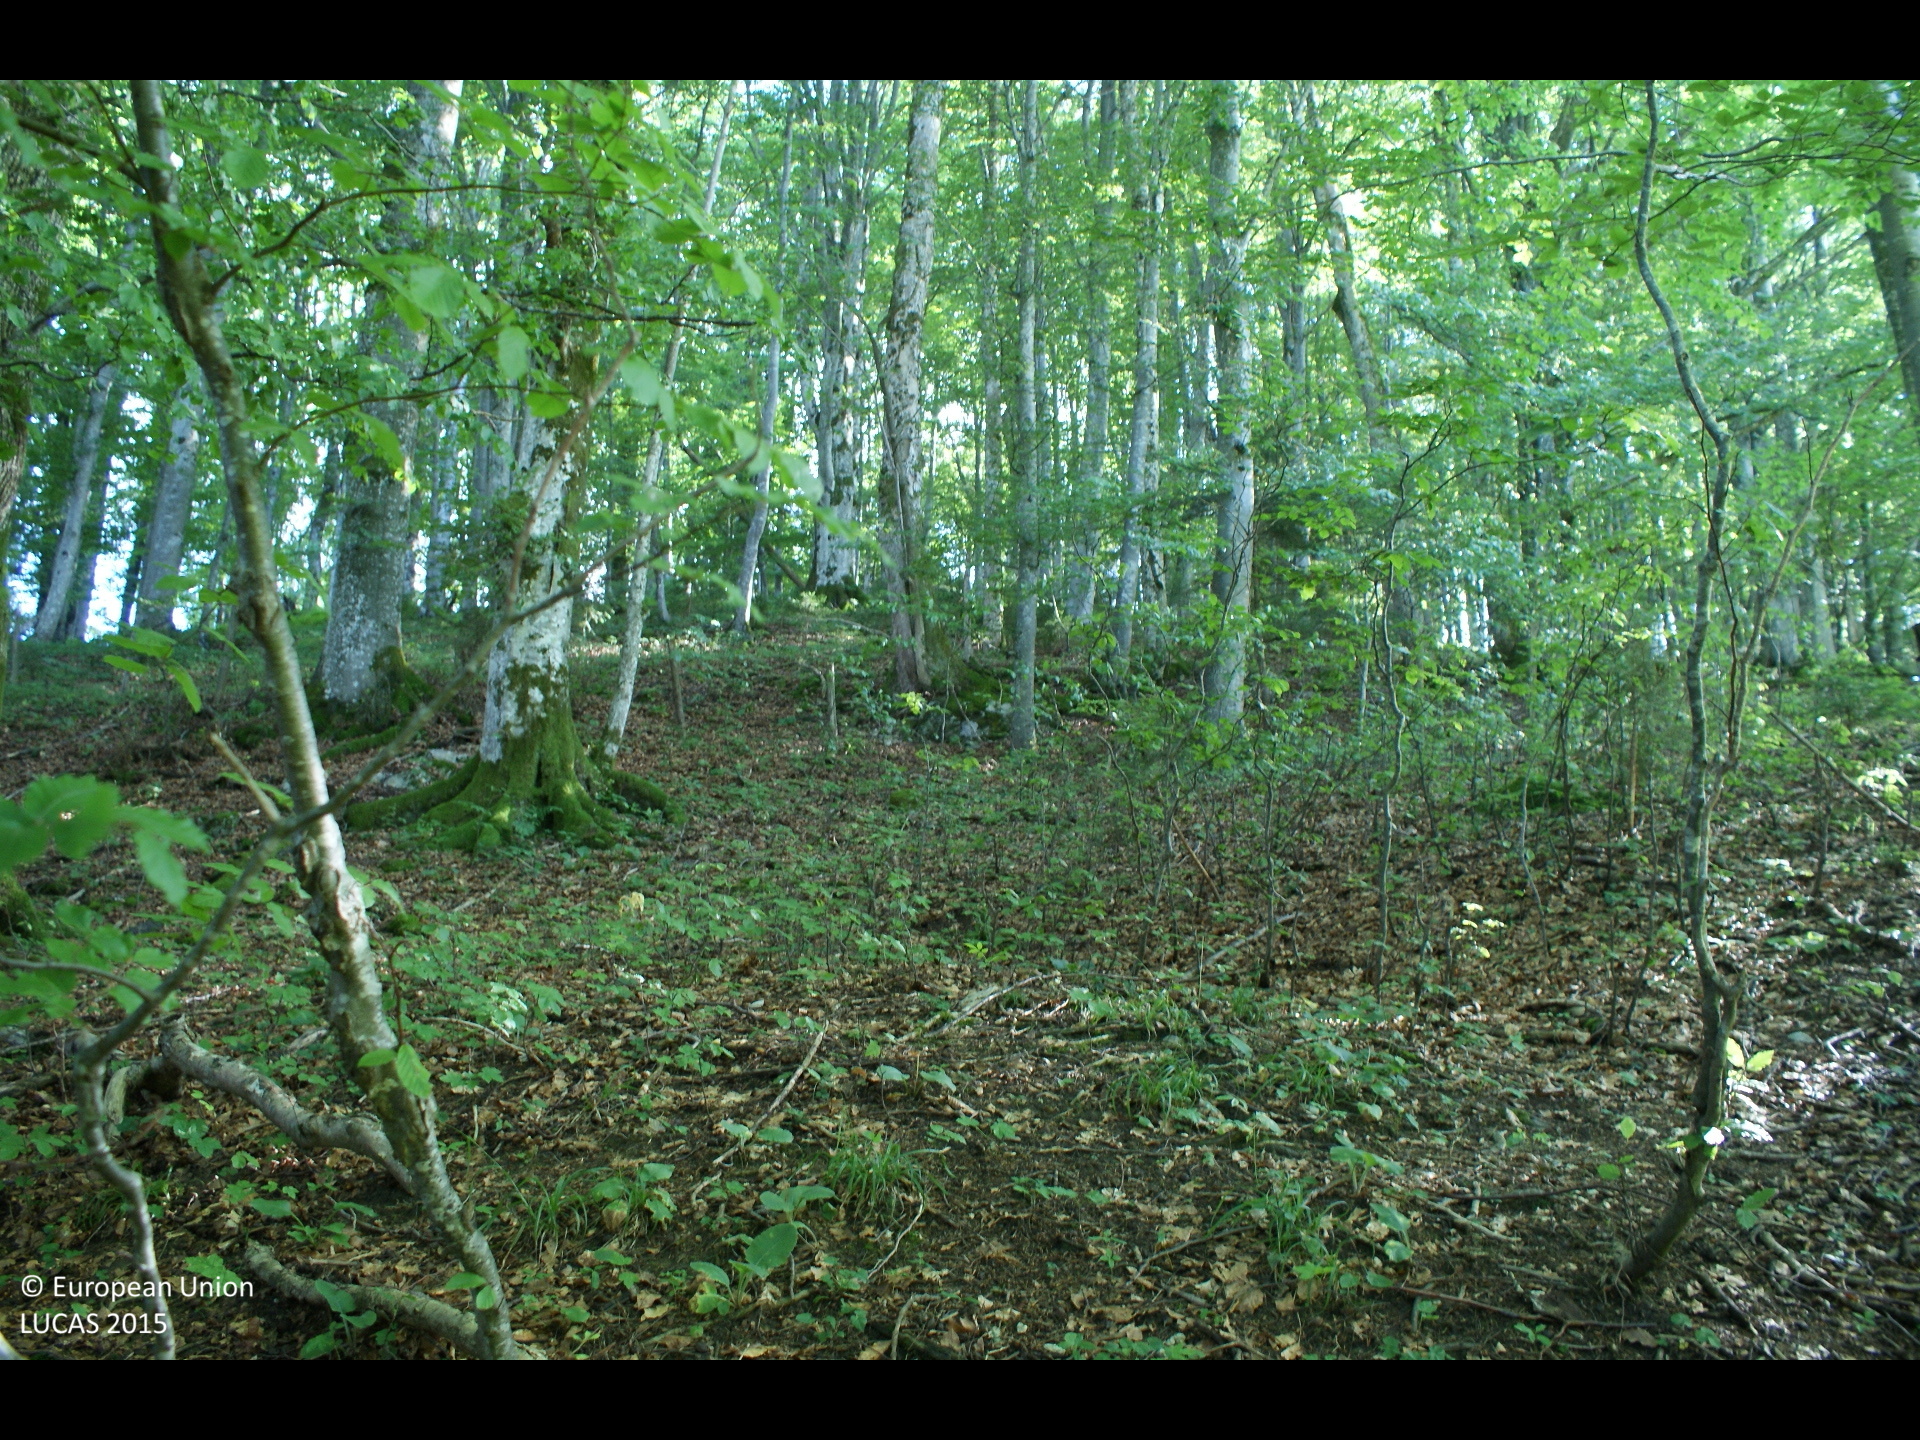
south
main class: Woodland
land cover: Broadleaved woodland
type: mountainous beech forest
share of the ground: > 75 %
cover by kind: broadleaved forest trees 75 %, coniferous forest trees 15 %, herbaceous plants 10 %
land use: Forestry
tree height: > 5 m
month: July
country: AT
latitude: 47.8930
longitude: 15.0163
